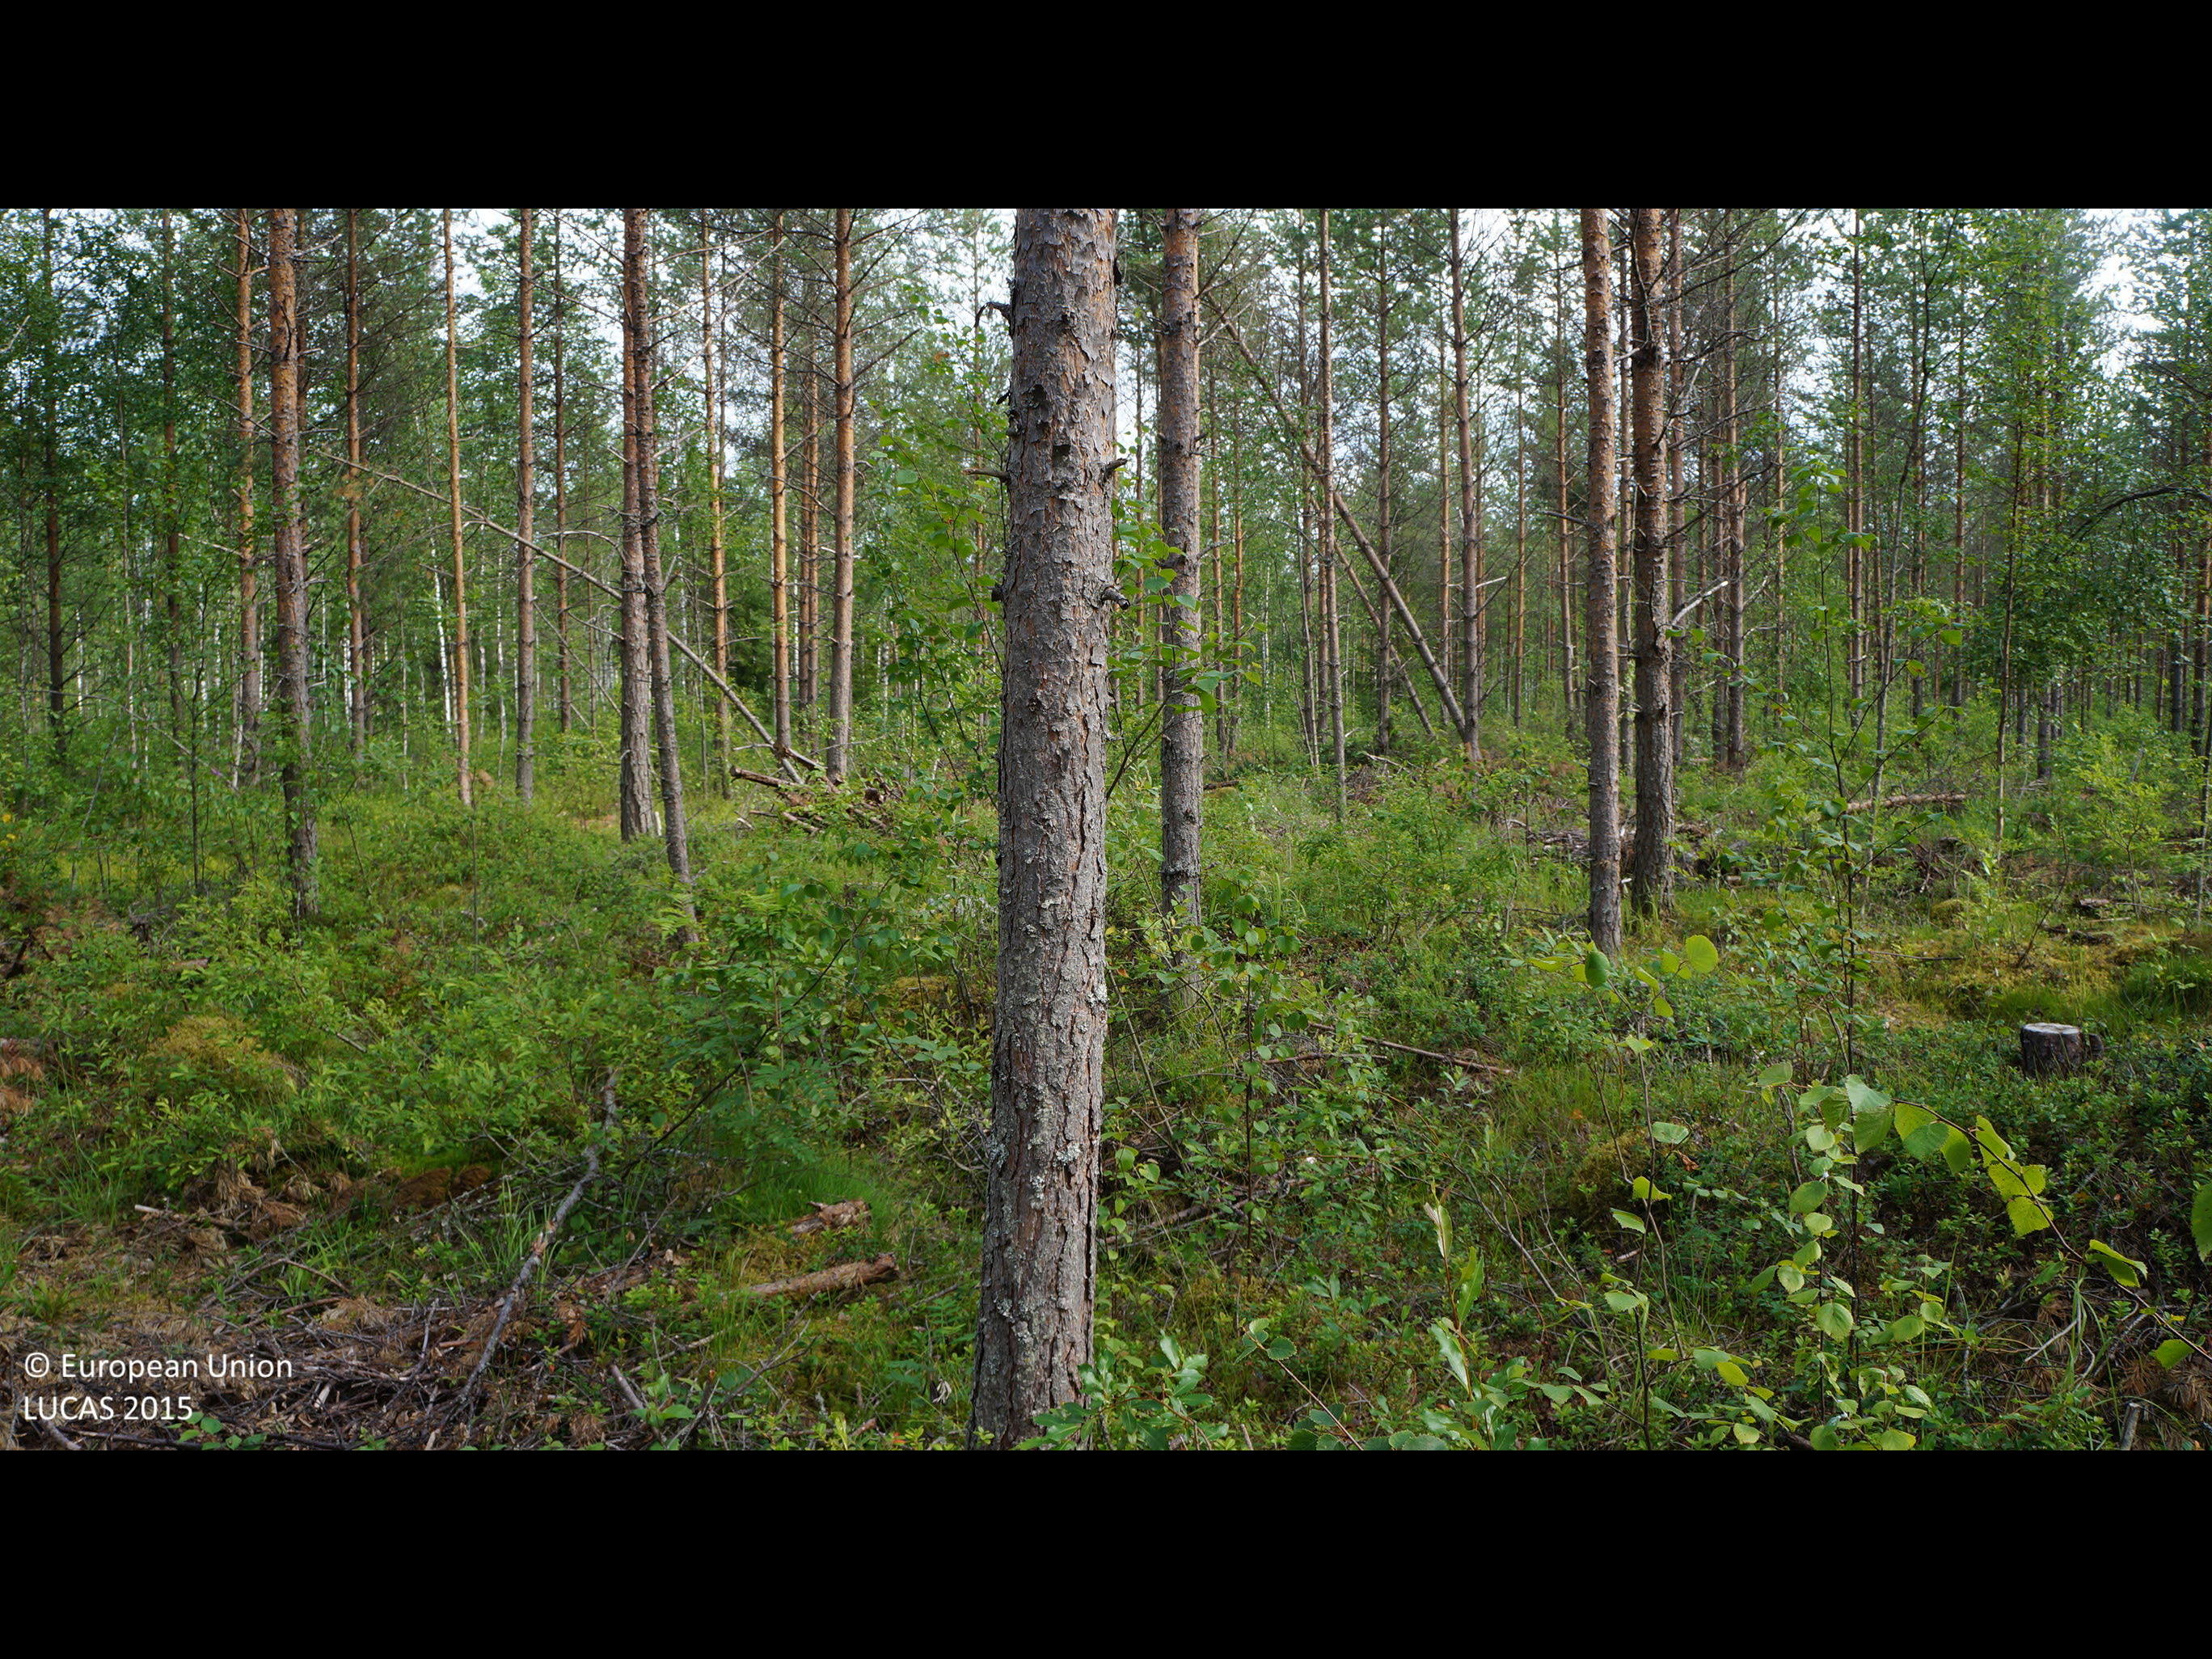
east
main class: Woodland
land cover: Pine dominated coniferous woodland
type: boreal forest
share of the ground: 25 - 50 %
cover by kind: shrubs 50 %, coniferous forest trees 40 %, herbaceous plants 5 %, lichens and mosses 5 %
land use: Forestry
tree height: > 5 m
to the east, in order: Pine dominated coniferous woodland; Ditches and canals; Pine dominated coniferous woodland; Ditches and canals; Pine dominated coniferous woodland; Ditches and canals; Pine dominated coniferous woodland; Ditches and canals; Broadleaved woodland; Ditches and canals; Pine dominated mixed woodland; Ditches and canals; Broadleaved woodland; Ditches and canals; Broadleaved woodland; Ditches and canals; Shruby margins; Tracks; Shruby margins; Ditches and canals; Other mixed woodland
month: July
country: FI
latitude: 64.0296
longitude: 24.4205
